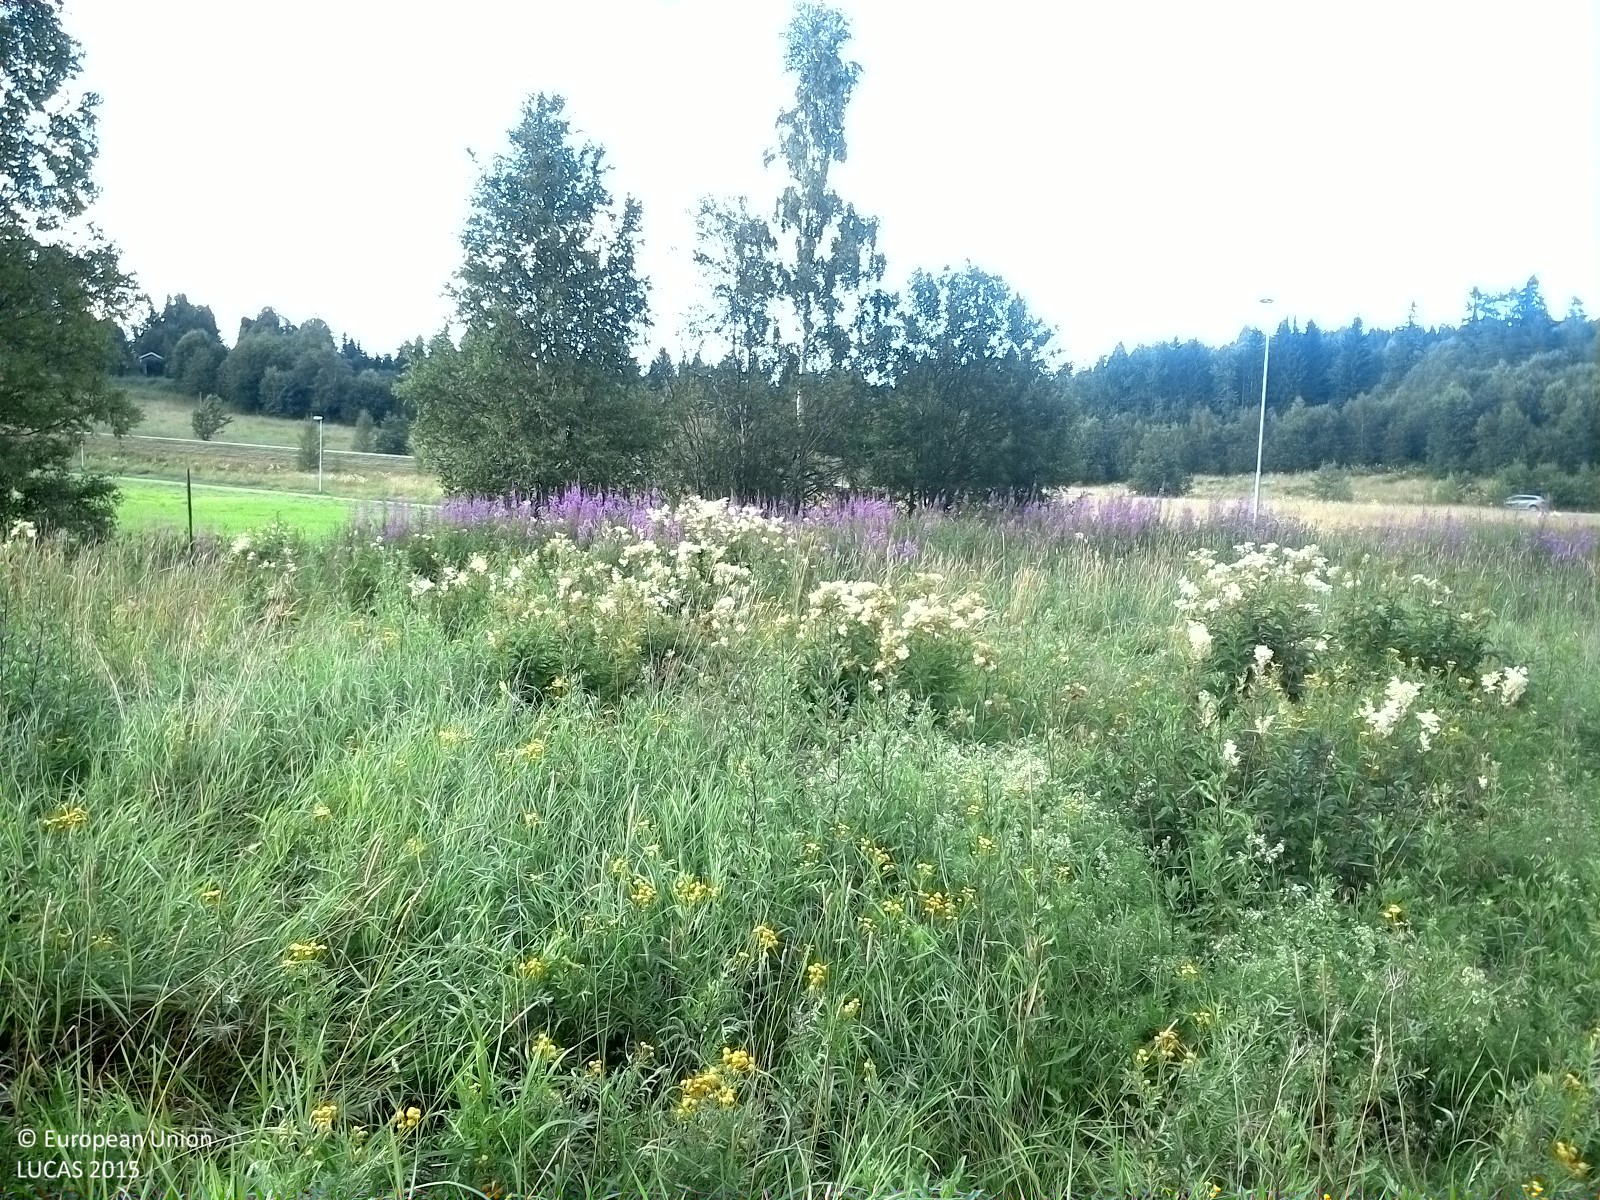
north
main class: Grassland
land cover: Grassland without tree/shrub cover
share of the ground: > 75 %
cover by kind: herbaceous plants 100 %
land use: Agriculture (excluding fallow land and kitchen gardens)
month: August
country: SE
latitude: 62.4181
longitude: 17.2788
